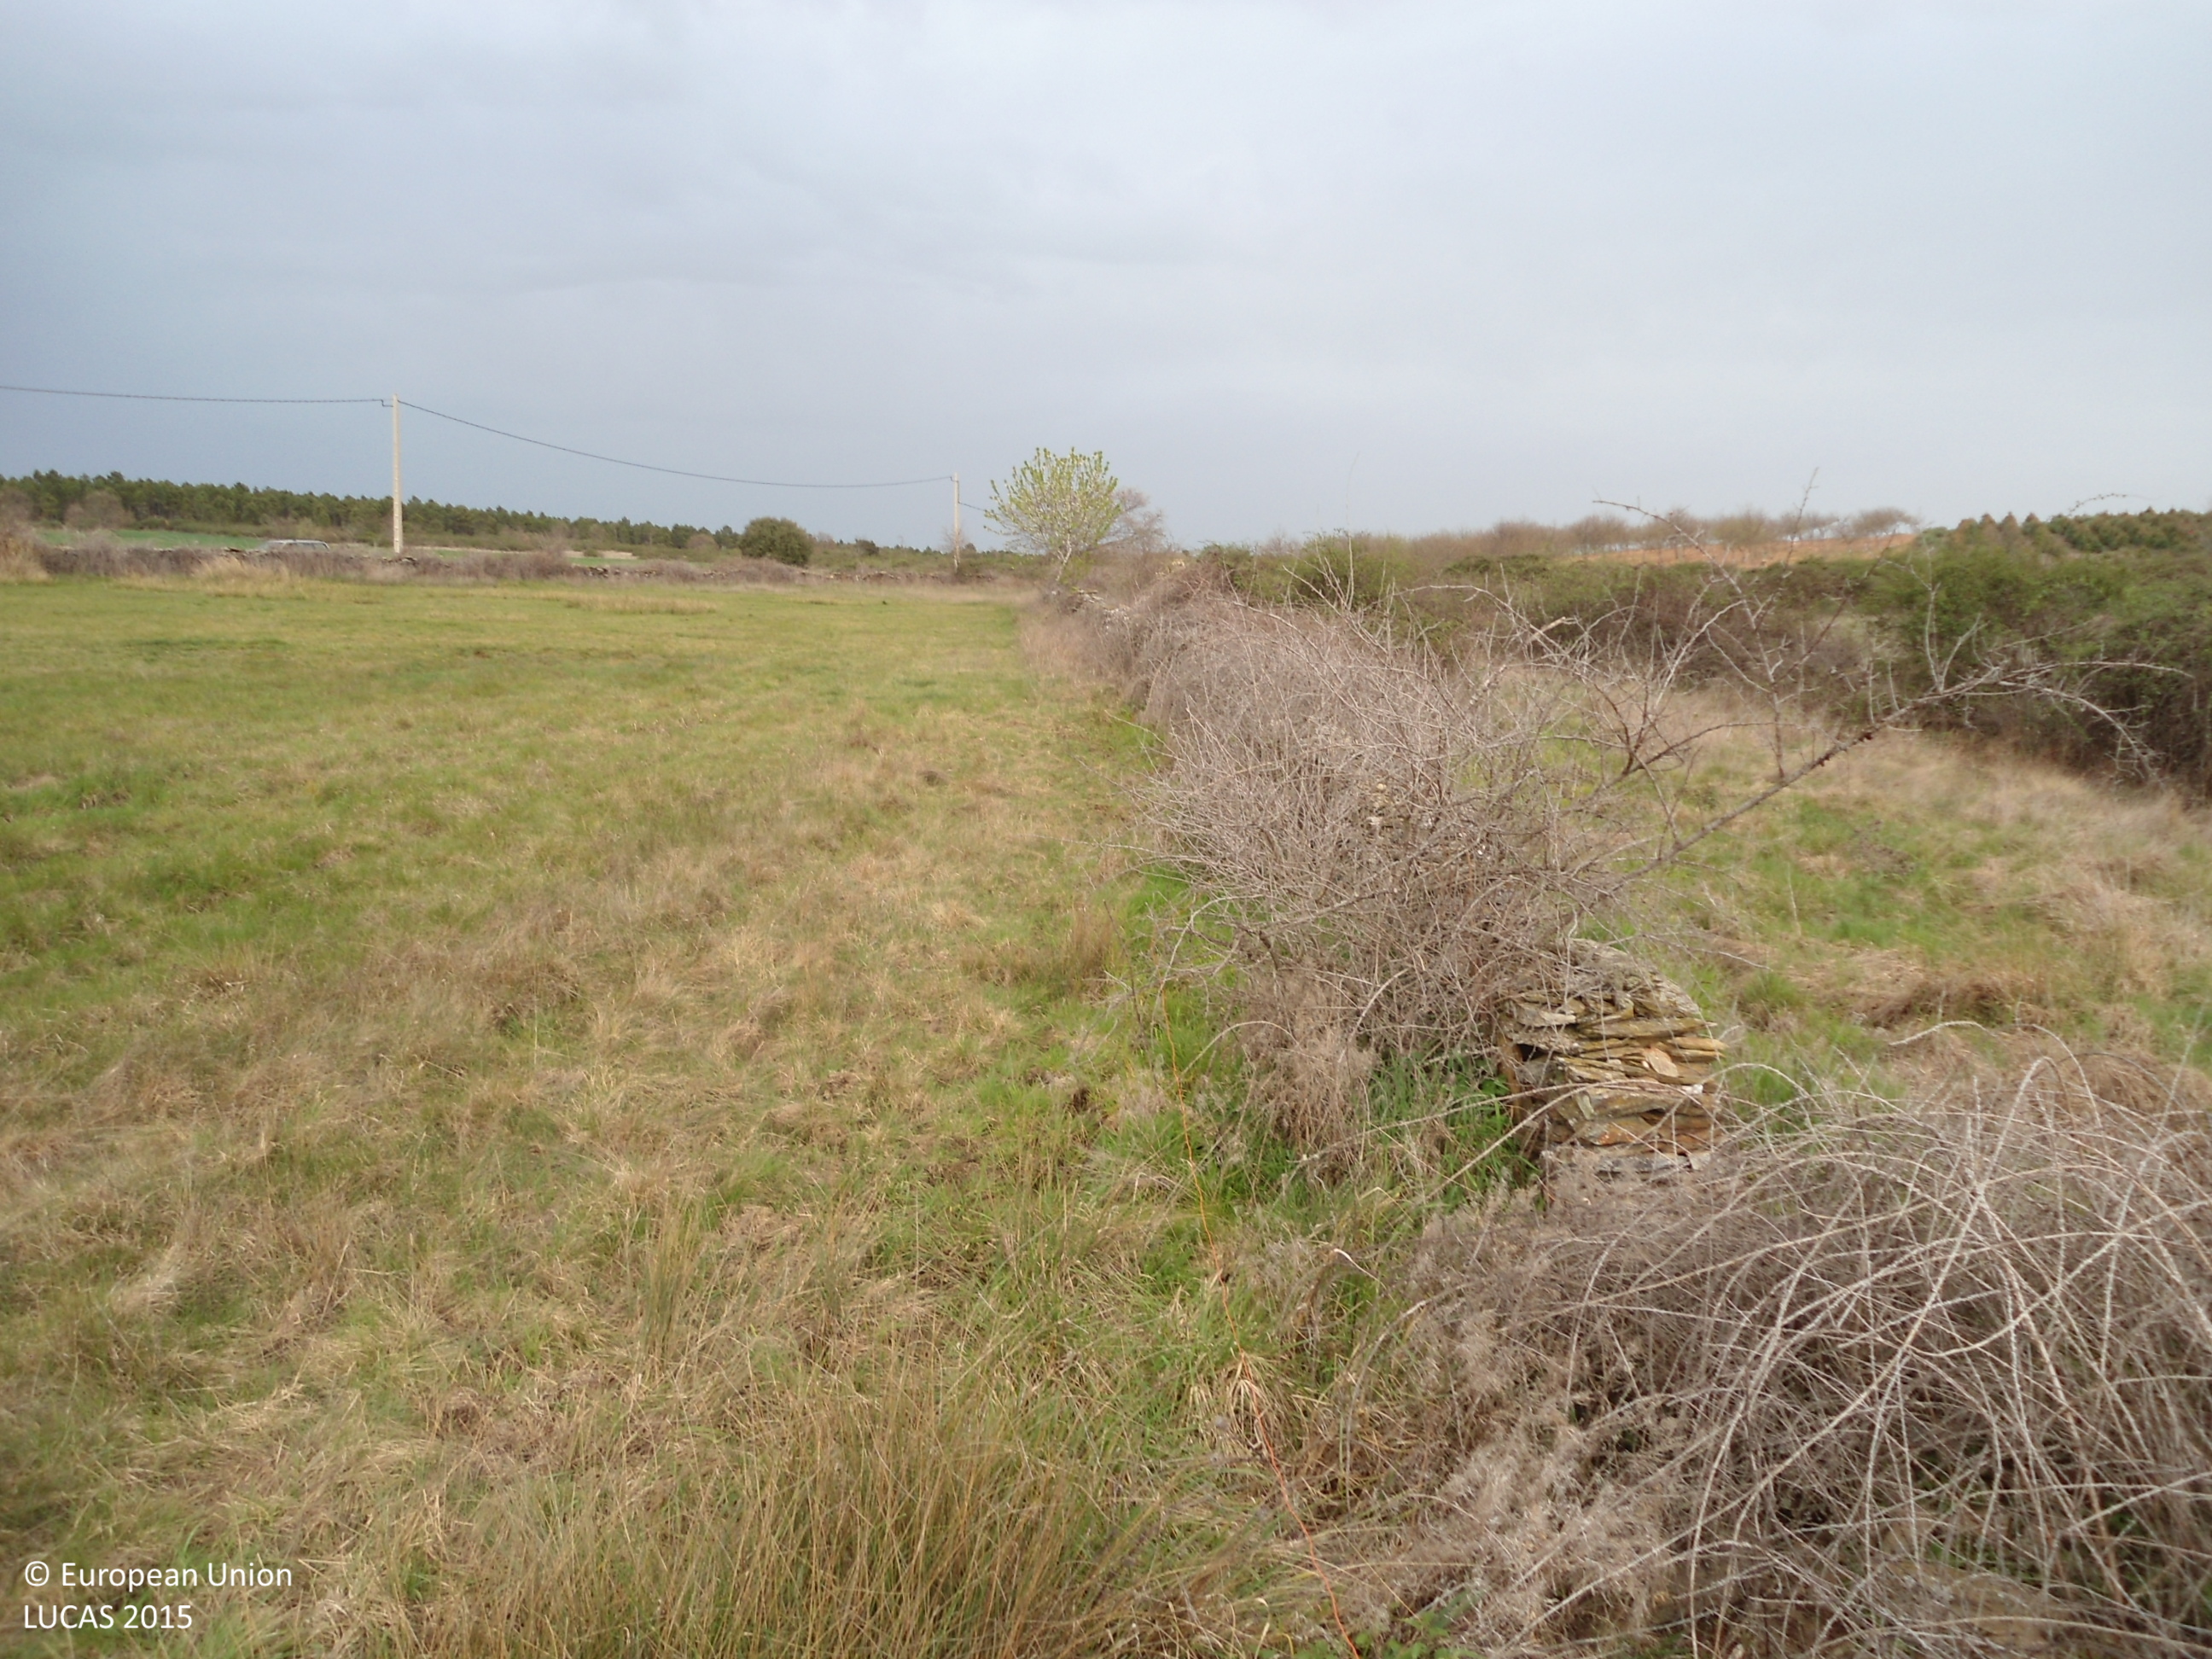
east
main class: Grassland
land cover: Grassland without tree/shrub cover
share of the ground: > 75 %
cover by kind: herbaceous plants 100 %
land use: Agriculture (excluding fallow land and kitchen gardens)
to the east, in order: Shruby margins; Grassland without tree/shrub cover; Abandoned hedges; Dry stone walls; Grassland with sparse tree/shrub cover; Abandoned hedges; Tracks; Abandoned hedges; Oats
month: April
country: ES
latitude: 41.7541
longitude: -6.4740
